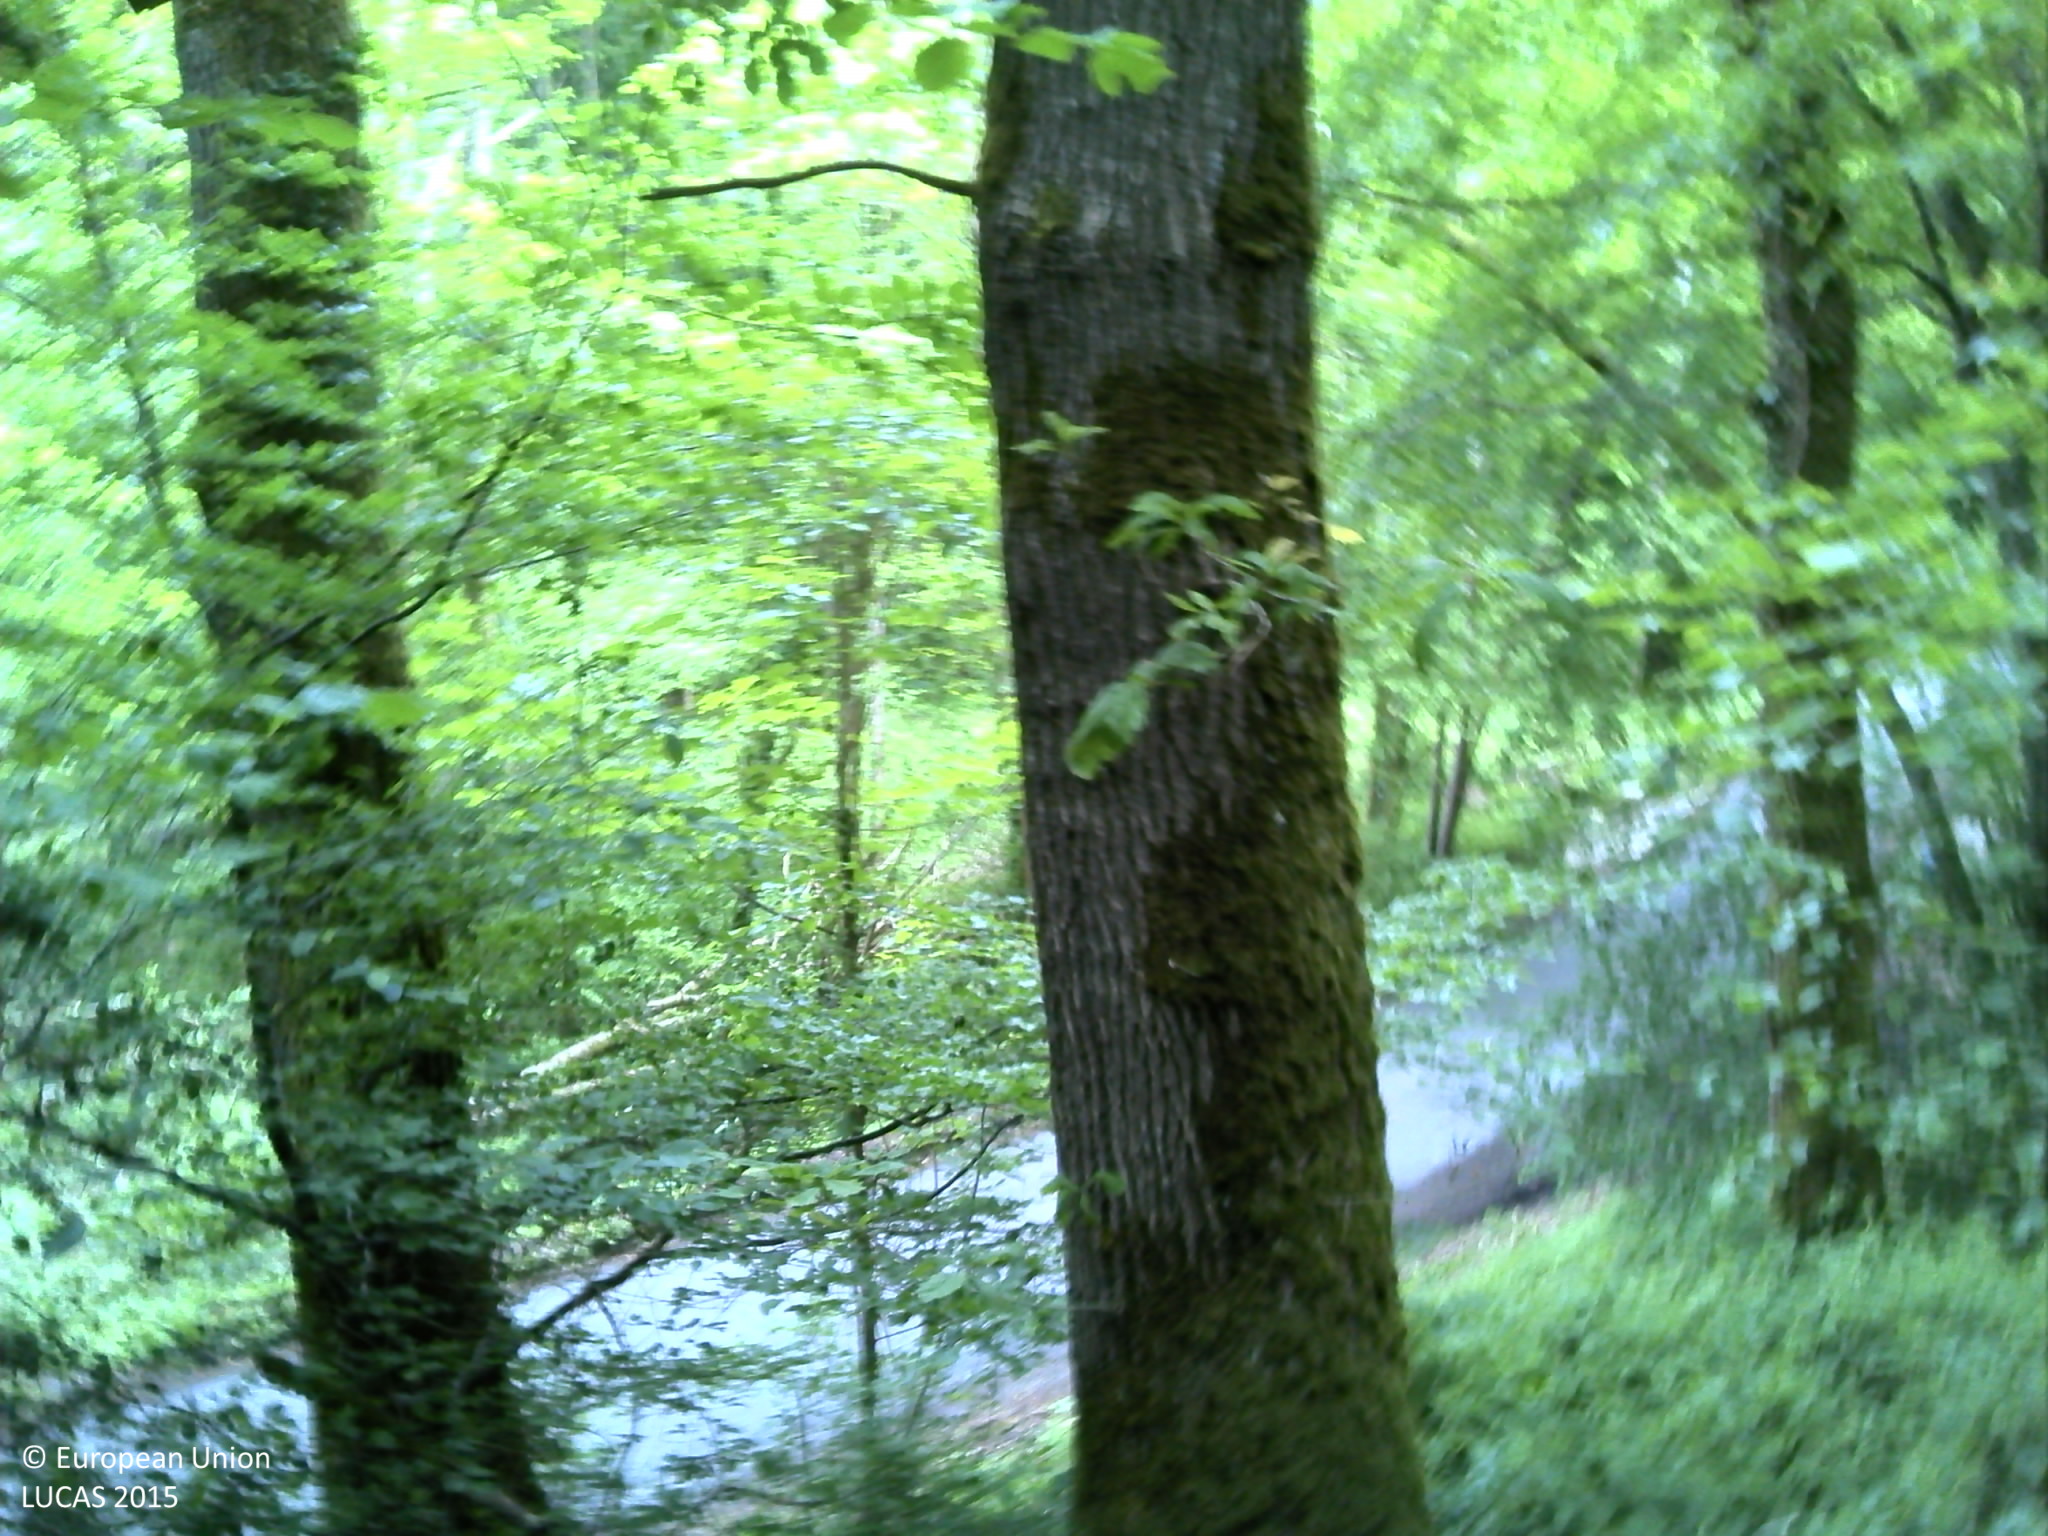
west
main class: Woodland
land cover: Broadleaved woodland
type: acidophilous oak and oak-birch forest
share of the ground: > 75 %
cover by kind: broadleaved forest trees 85 %, herbaceous plants 15 %
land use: Forestry
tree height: > 5 m
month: June
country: FR
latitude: 49.5746
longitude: 1.0025
